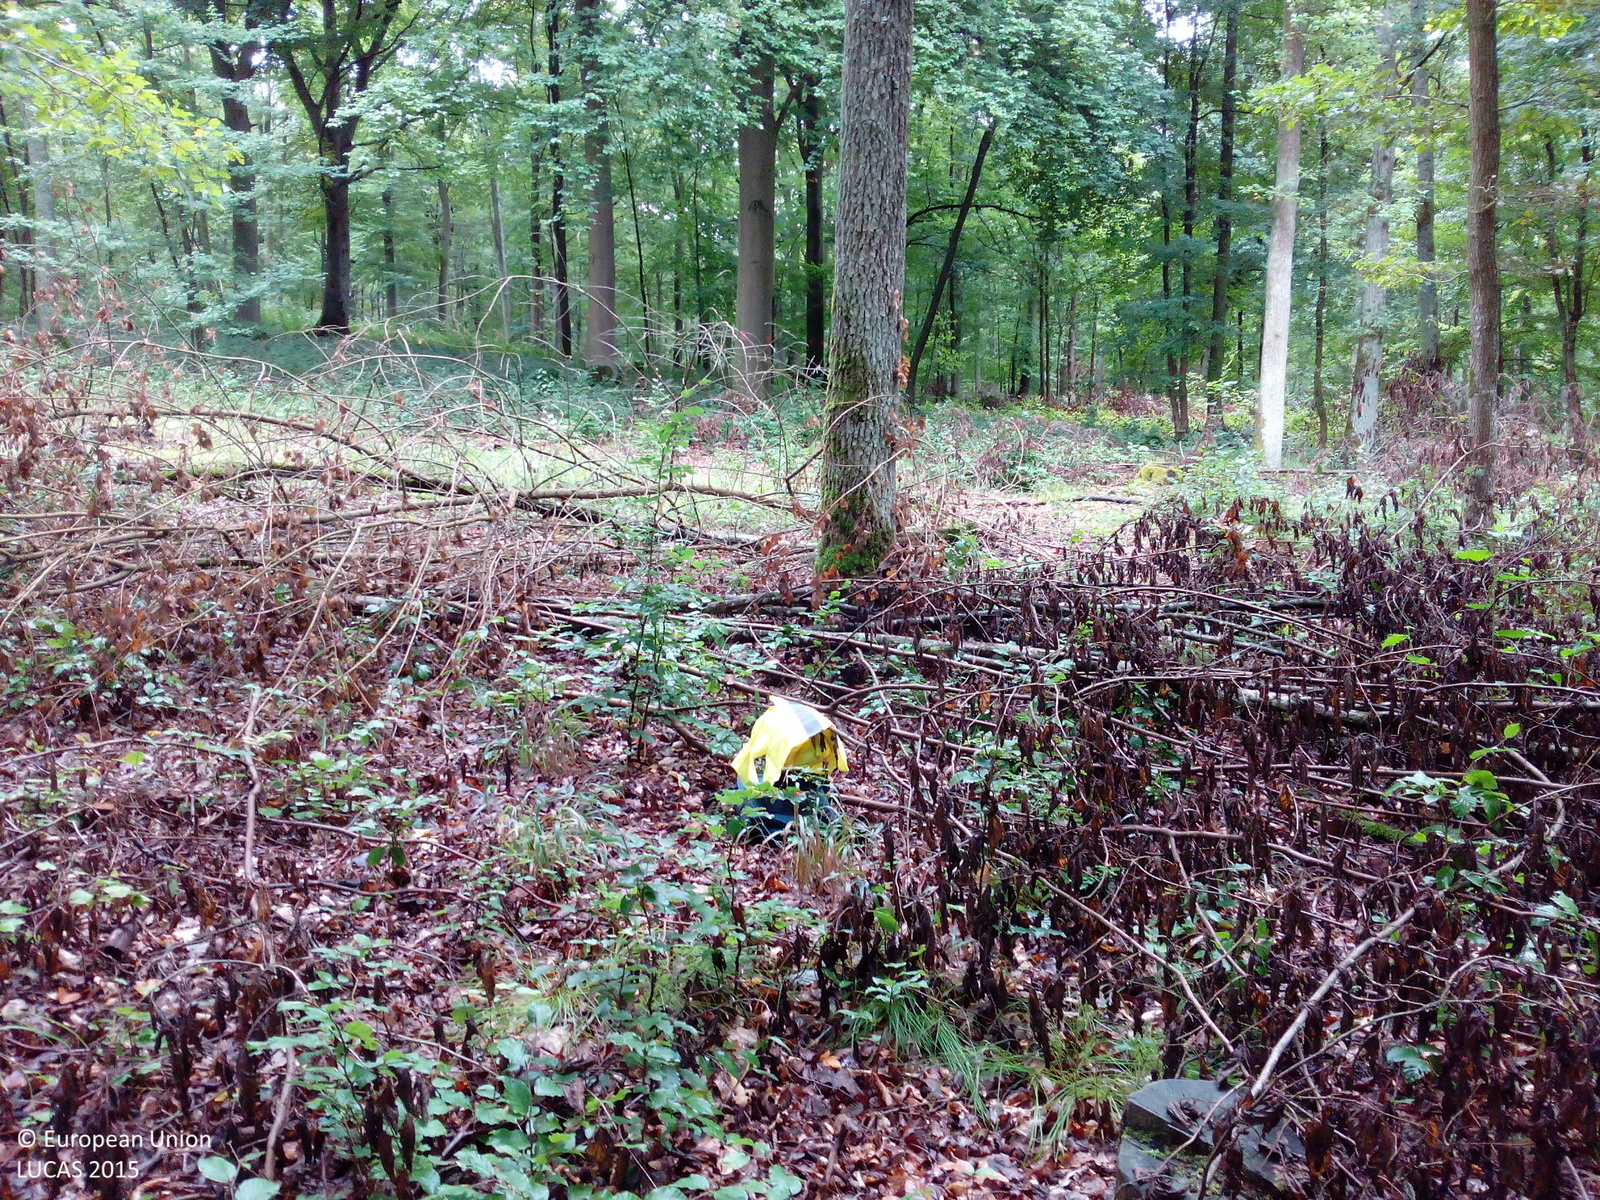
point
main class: Woodland
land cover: Broadleaved woodland
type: mesophytic deciduous forest
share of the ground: > 75 %
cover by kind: broadleaved forest trees 90 %, herbaceous plants 5 %, unconsolidated bare surface 5 %
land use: Forestry
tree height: > 5 m
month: September
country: DE
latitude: 50.0763
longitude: 9.9581
